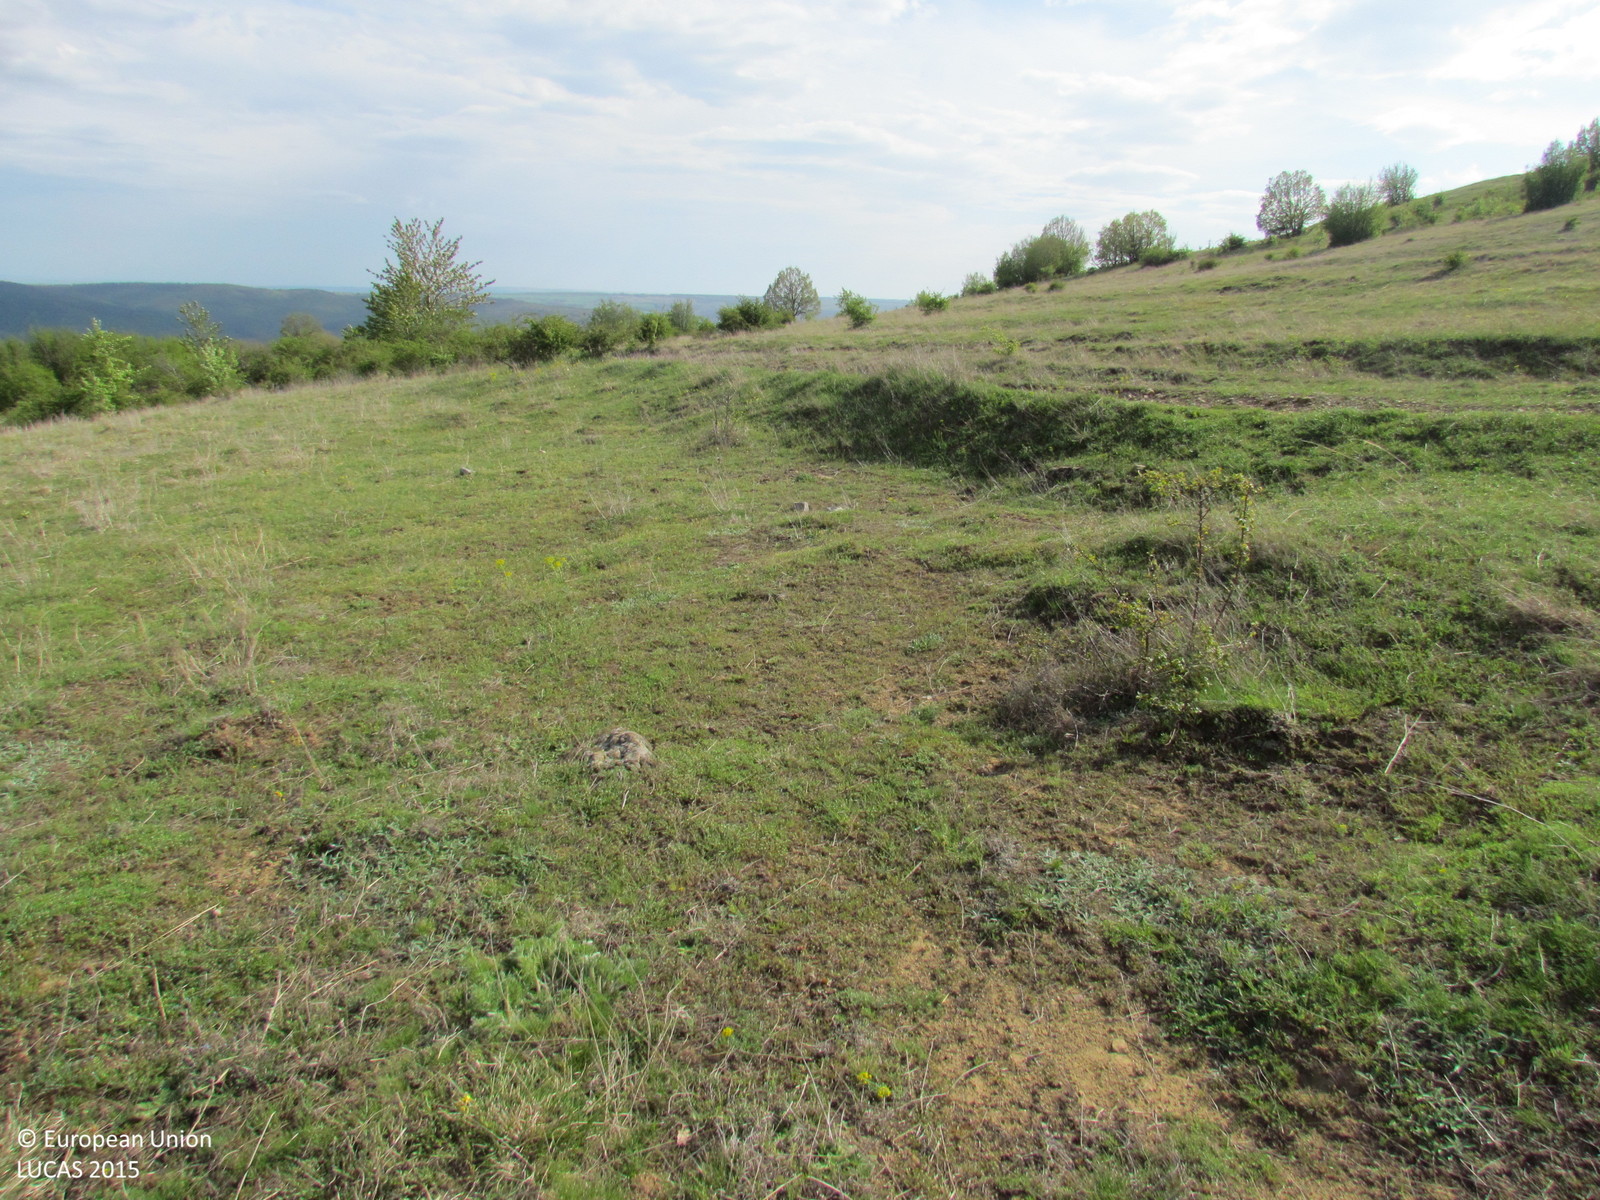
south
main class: Grassland
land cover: Grassland without tree/shrub cover
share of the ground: > 75 %
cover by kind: herbaceous plants 100 %
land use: Agriculture (excluding fallow land and kitchen gardens)
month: April
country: BG
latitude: 42.8824
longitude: 26.7670
